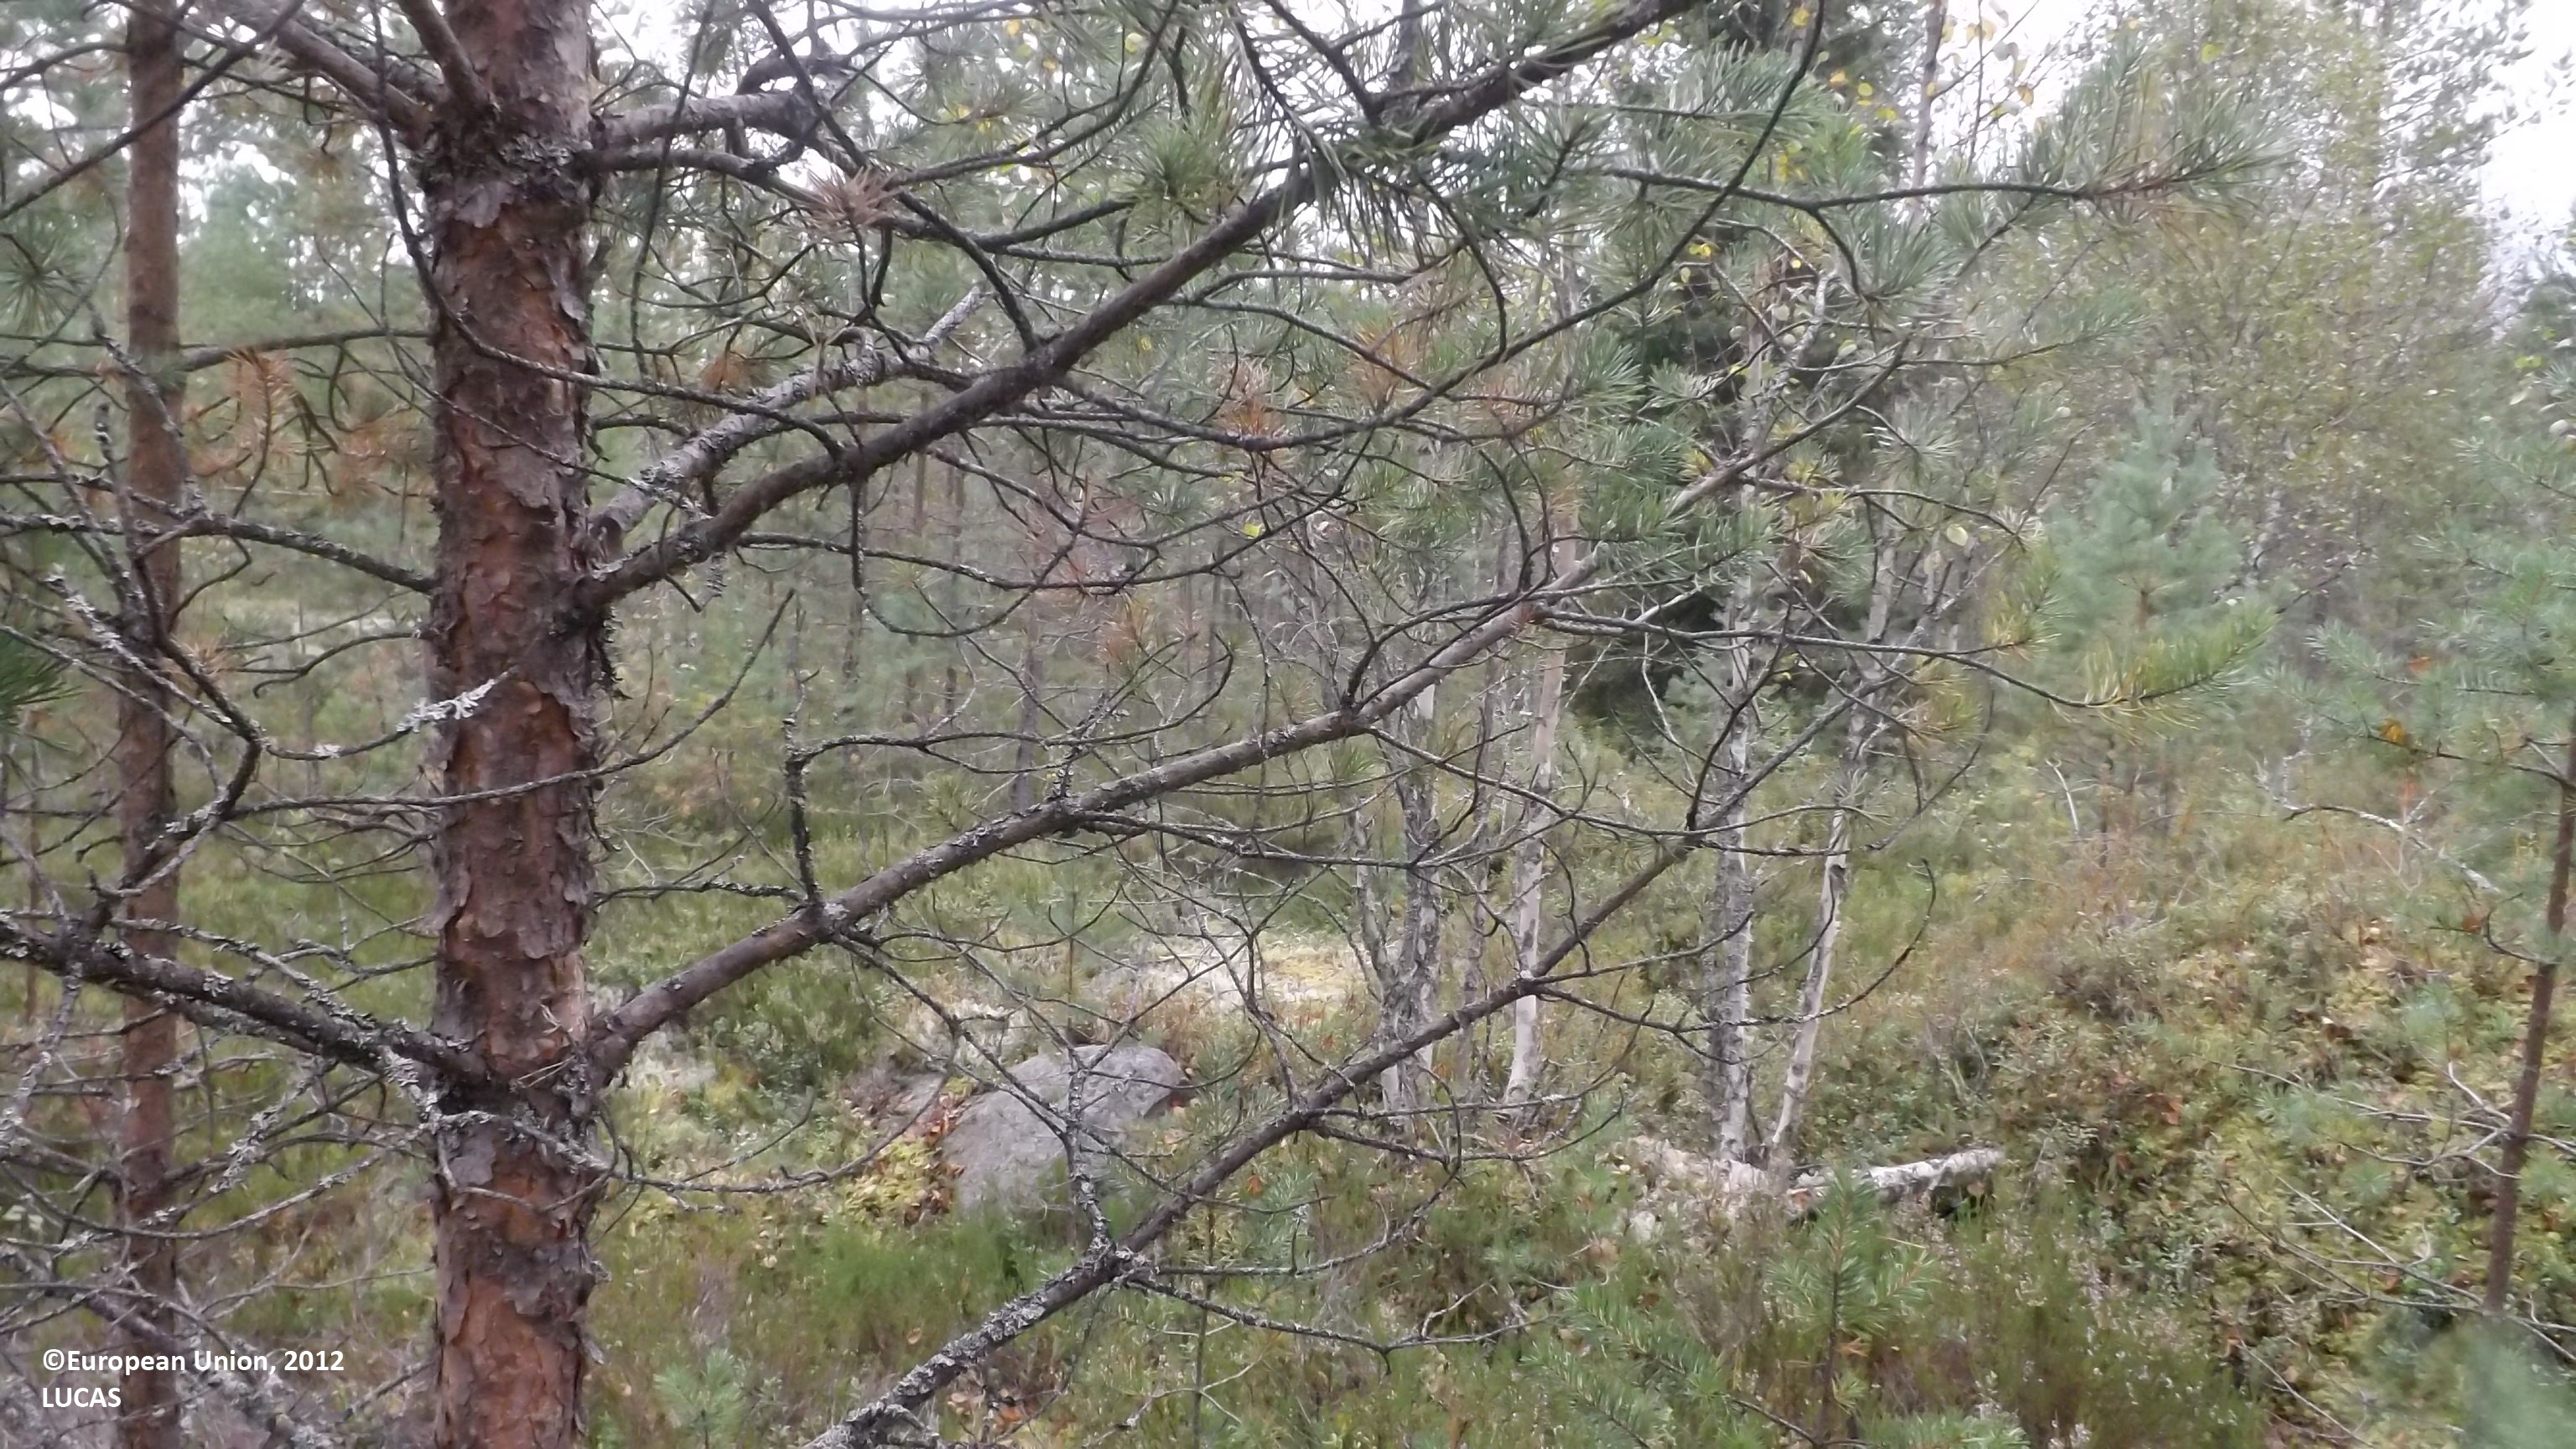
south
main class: Woodland
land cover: Pine dominated mixed woodland
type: boreal forest
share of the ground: 50 - 75 %
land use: Forestry
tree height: > 5 m
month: August
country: FI
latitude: 63.7734
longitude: 24.0014
